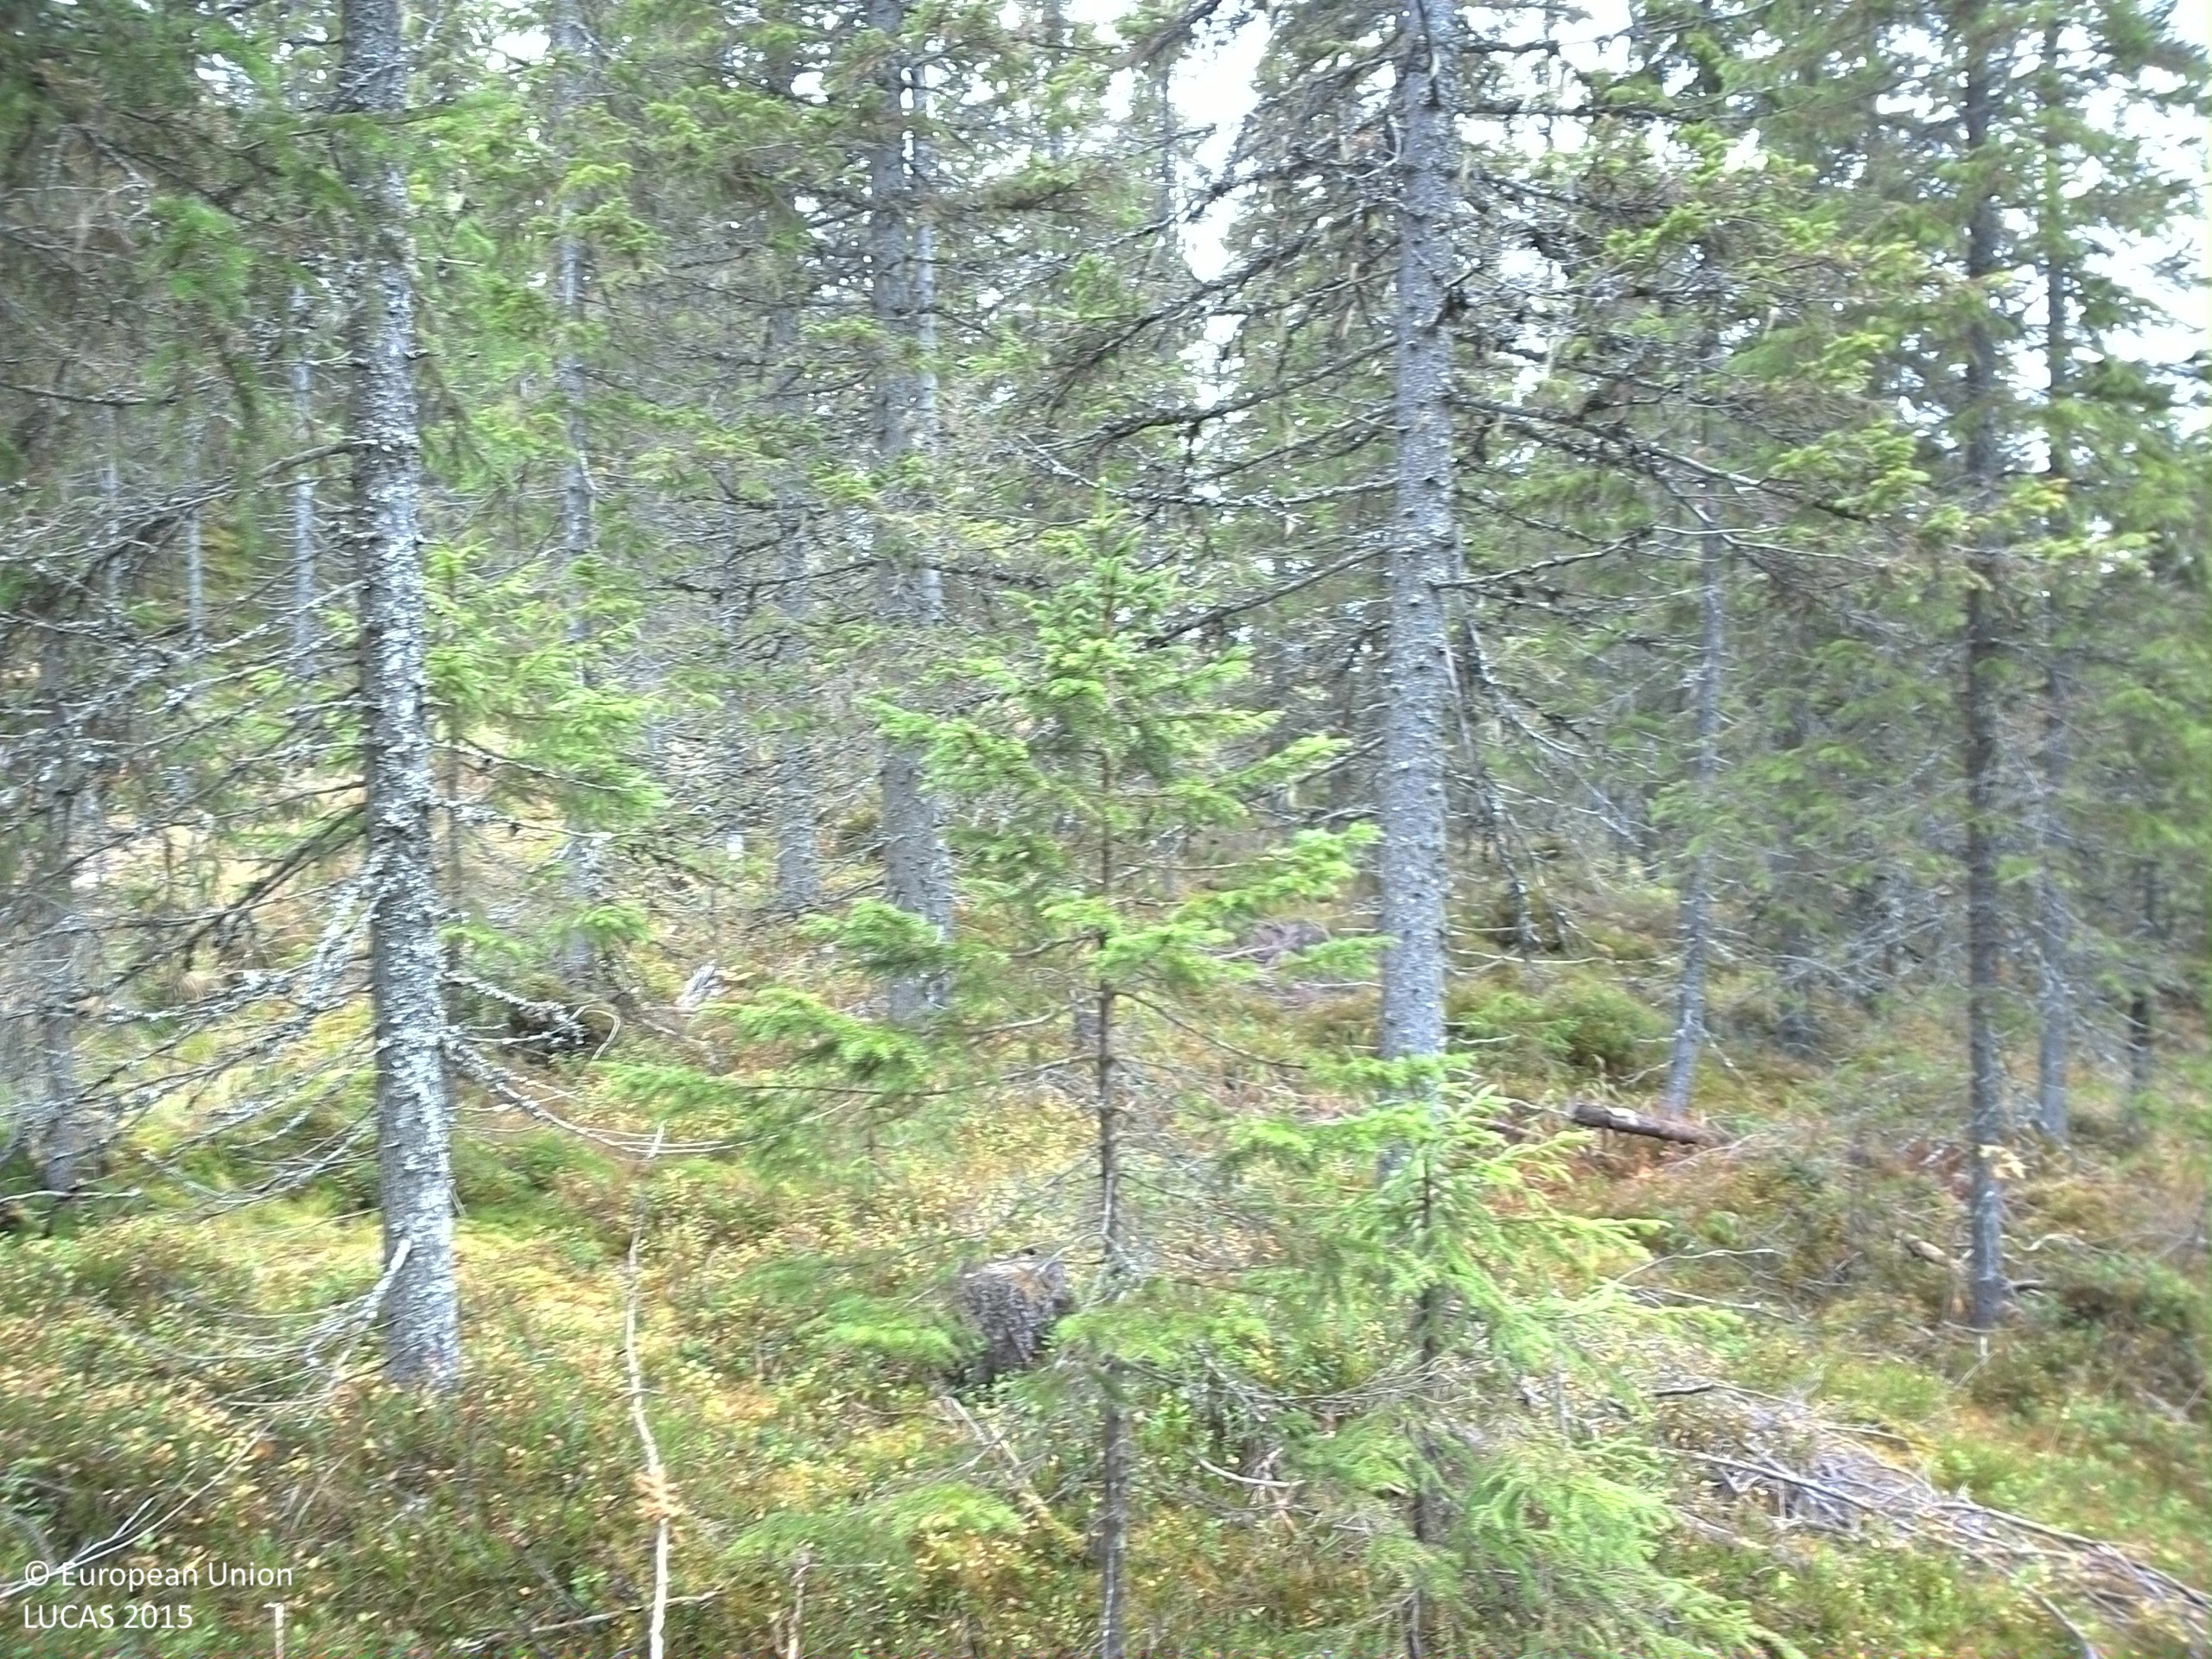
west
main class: Woodland
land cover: Spruce dominated coniferous woodland
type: boreal forest
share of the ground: 50 - 75 %
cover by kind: coniferous forest trees 50 %, shrubs 30 %, lichens and mosses 20 %
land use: Forestry
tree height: > 5 m
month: October
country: SE
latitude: 61.3672
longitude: 14.6433
